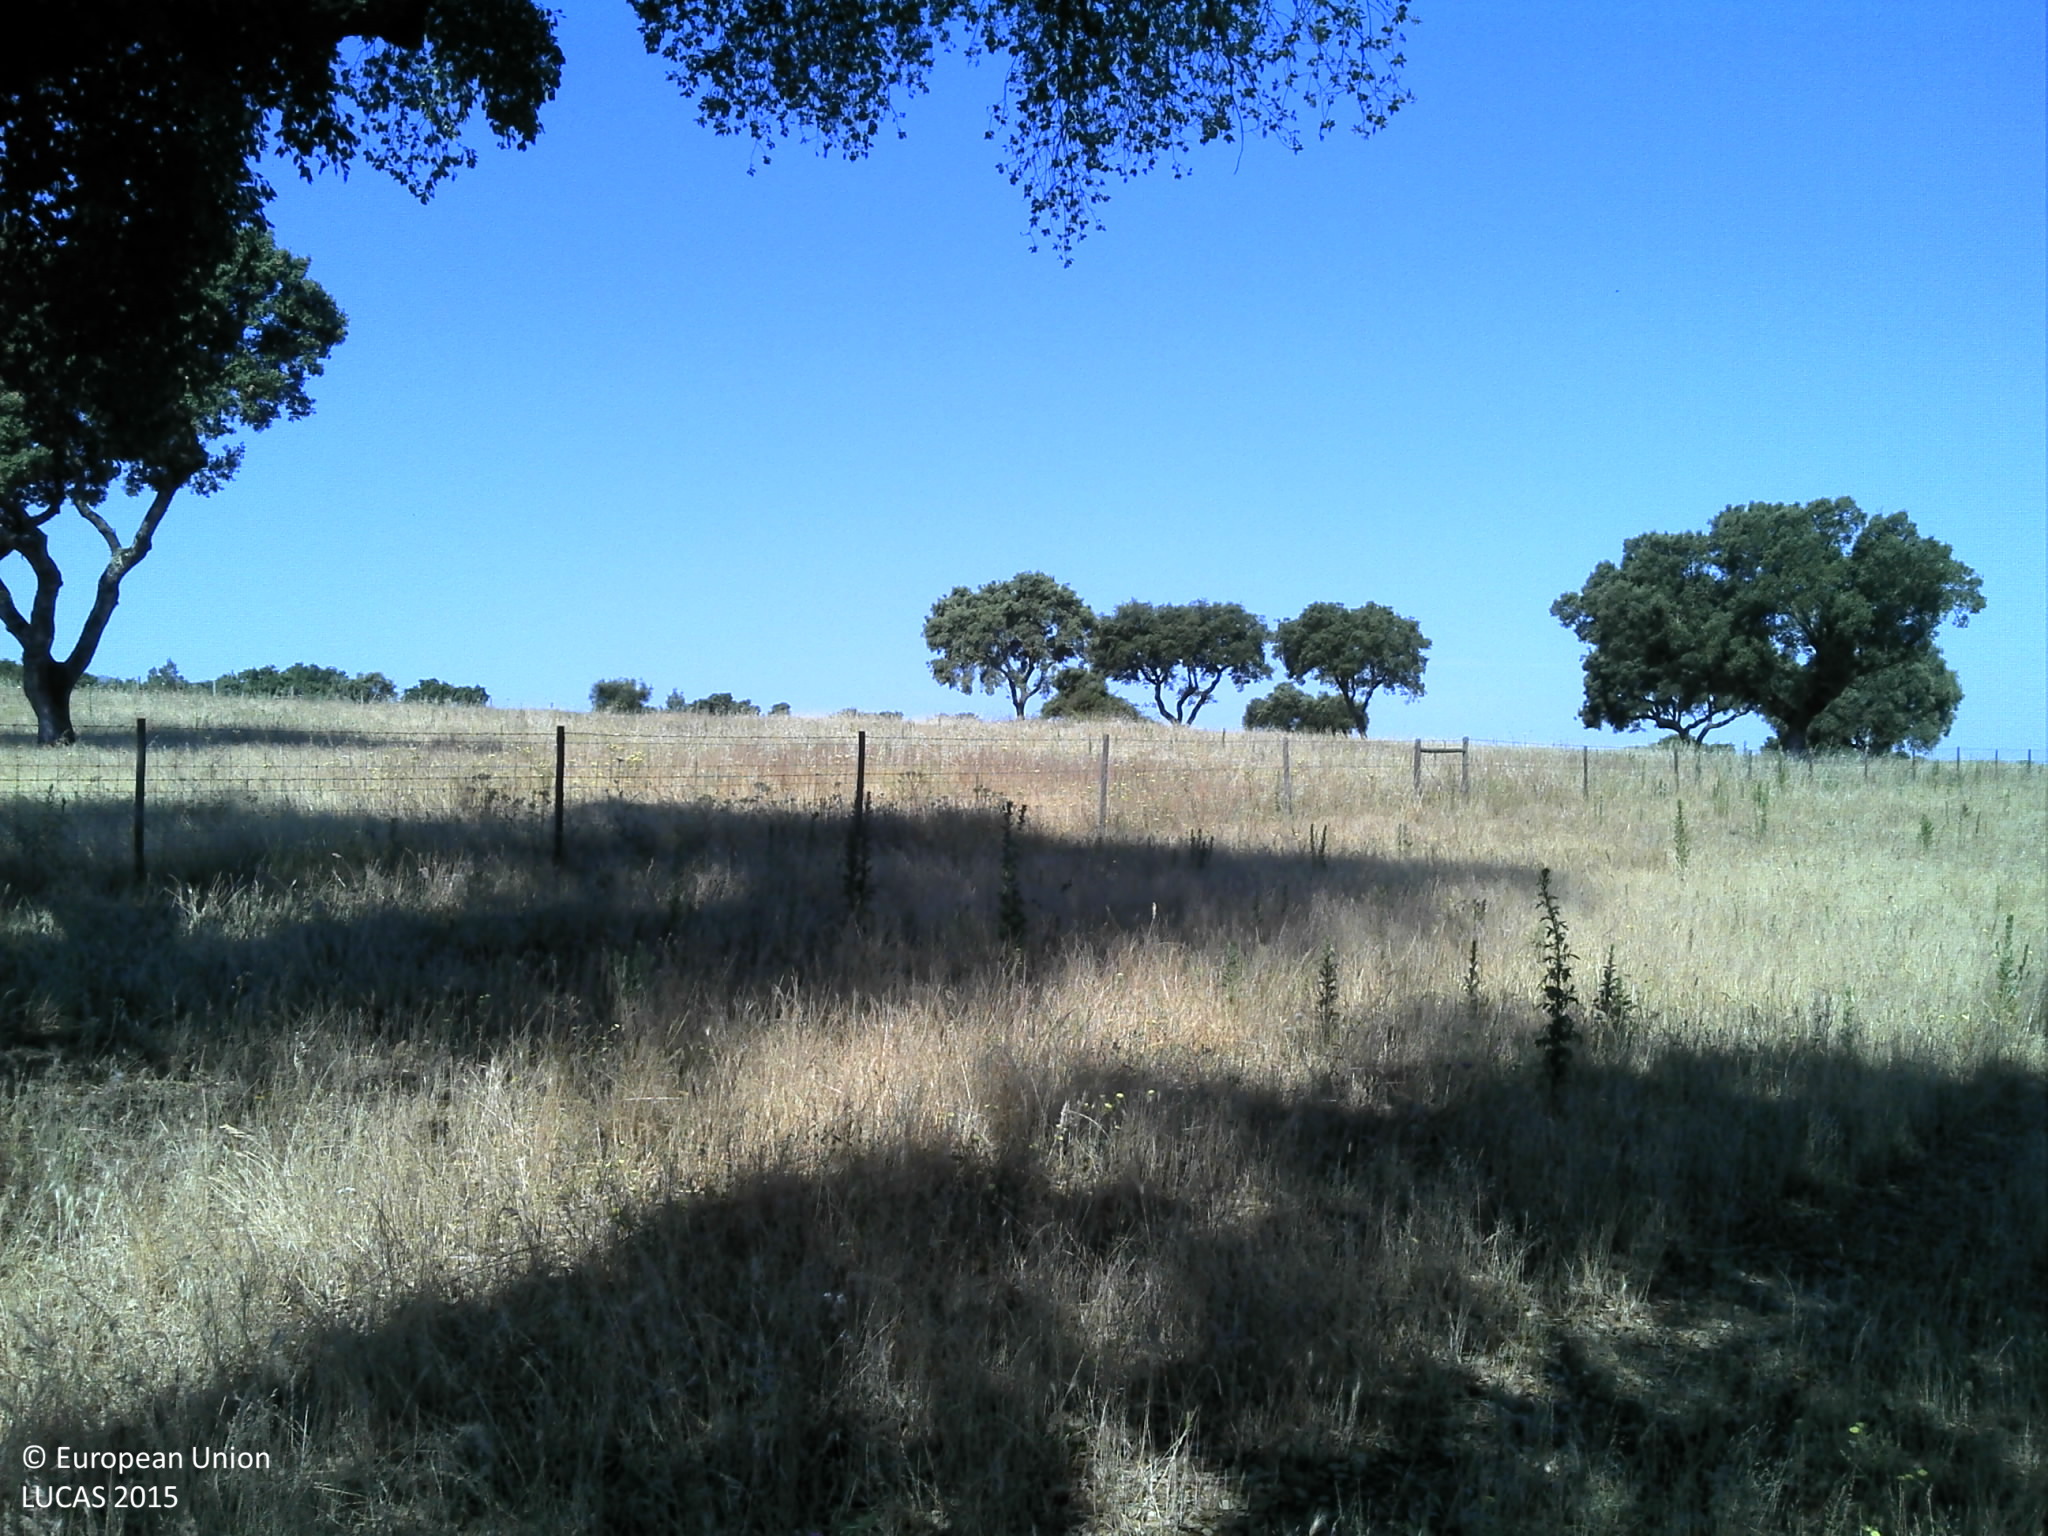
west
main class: Woodland
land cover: Broadleaved woodland
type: broadleaved evergreen forest
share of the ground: 10 - 25 %
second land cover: Spontaneously vegetated surfaces
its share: 25 - 50 %
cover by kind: herbaceous plants 50 %, unconsolidated bare surface 30 %, broadleaved forest trees 20 %
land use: Forestry
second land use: Agriculture (excluding fallow land and kitchen gardens)
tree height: > 5 m
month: June
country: PT
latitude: 38.6120
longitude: -8.0628
